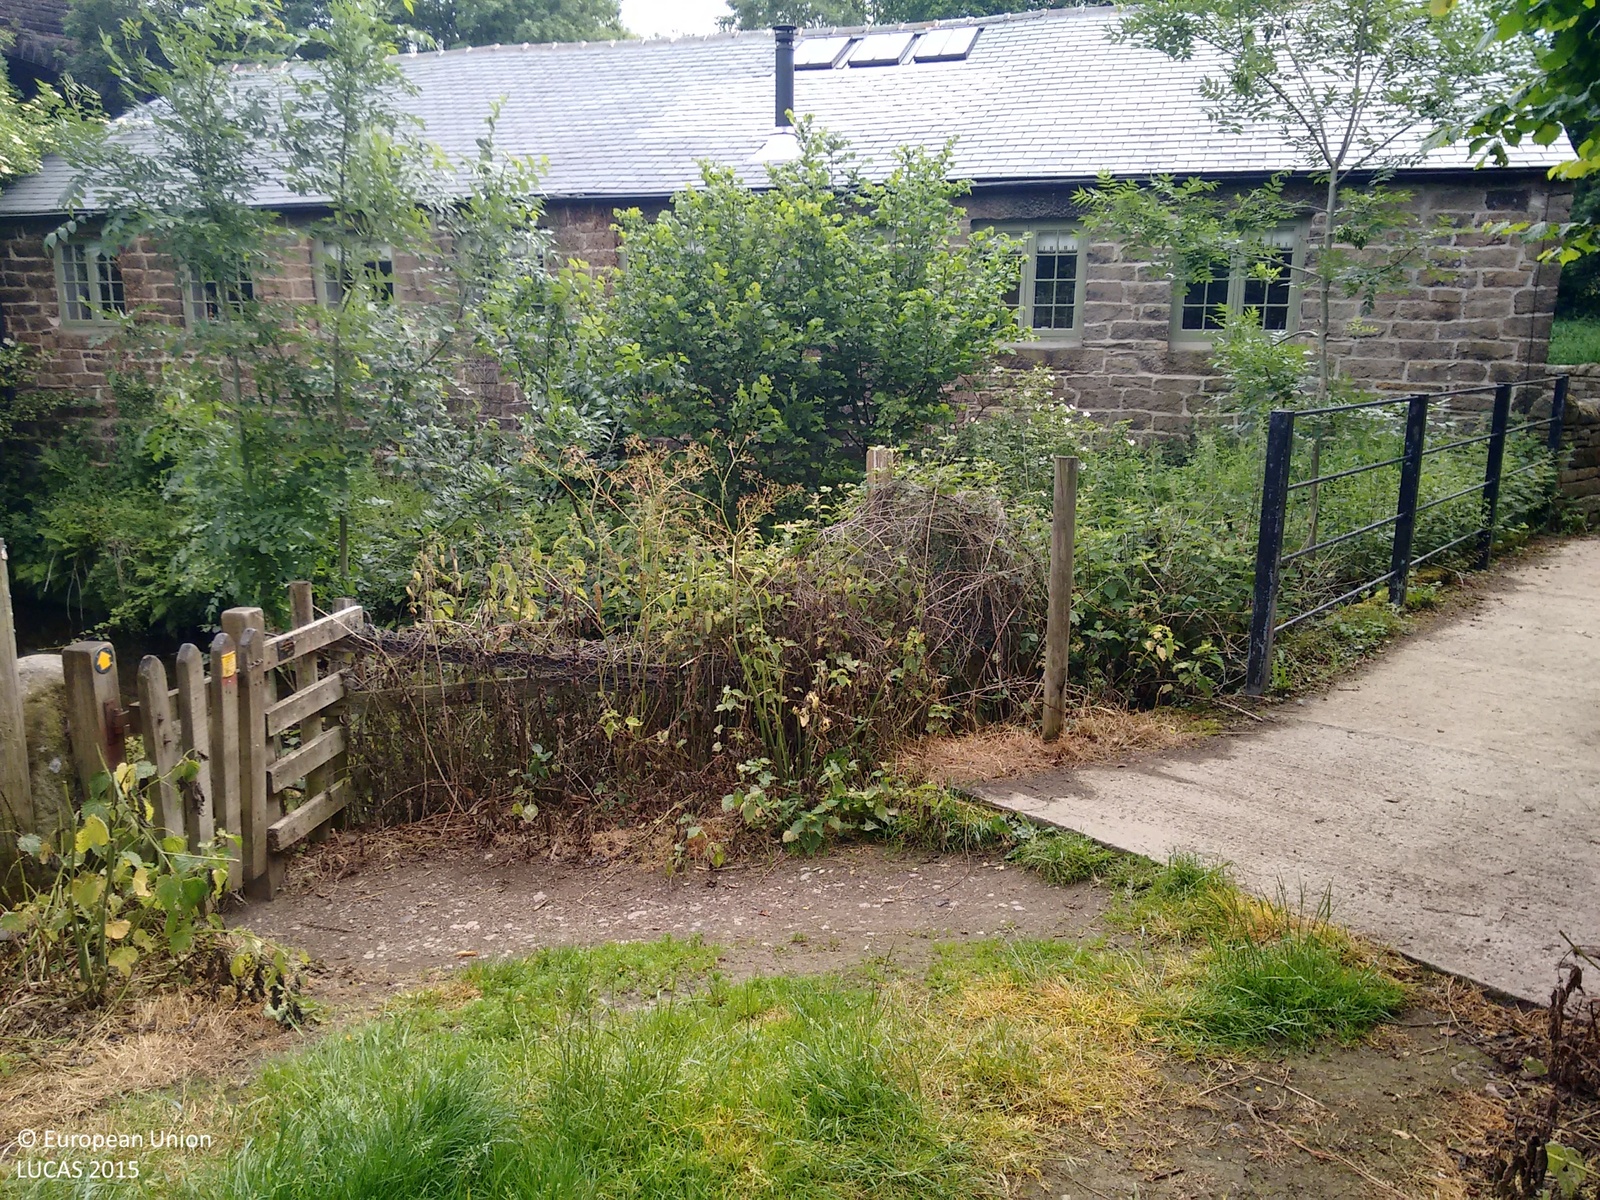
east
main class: Grassland
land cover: Grassland without tree/shrub cover
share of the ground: > 75 %
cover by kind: herbaceous plants 100 %
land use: Agriculture (excluding fallow land and kitchen gardens)
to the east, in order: Grassland without tree/shrub cover; Fences; Abandoned hedges; Rivers and streams; Broadleaved woodland; Paved roads, cycling and walking lanes; Electric lines; Broadleaved woodland; Fences; Common wheat; Fences; Broadleaved woodland; Railways; Abandoned hedges; Artificial constructions in urban areas
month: June
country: GB
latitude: 53.3272
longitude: -1.6587
